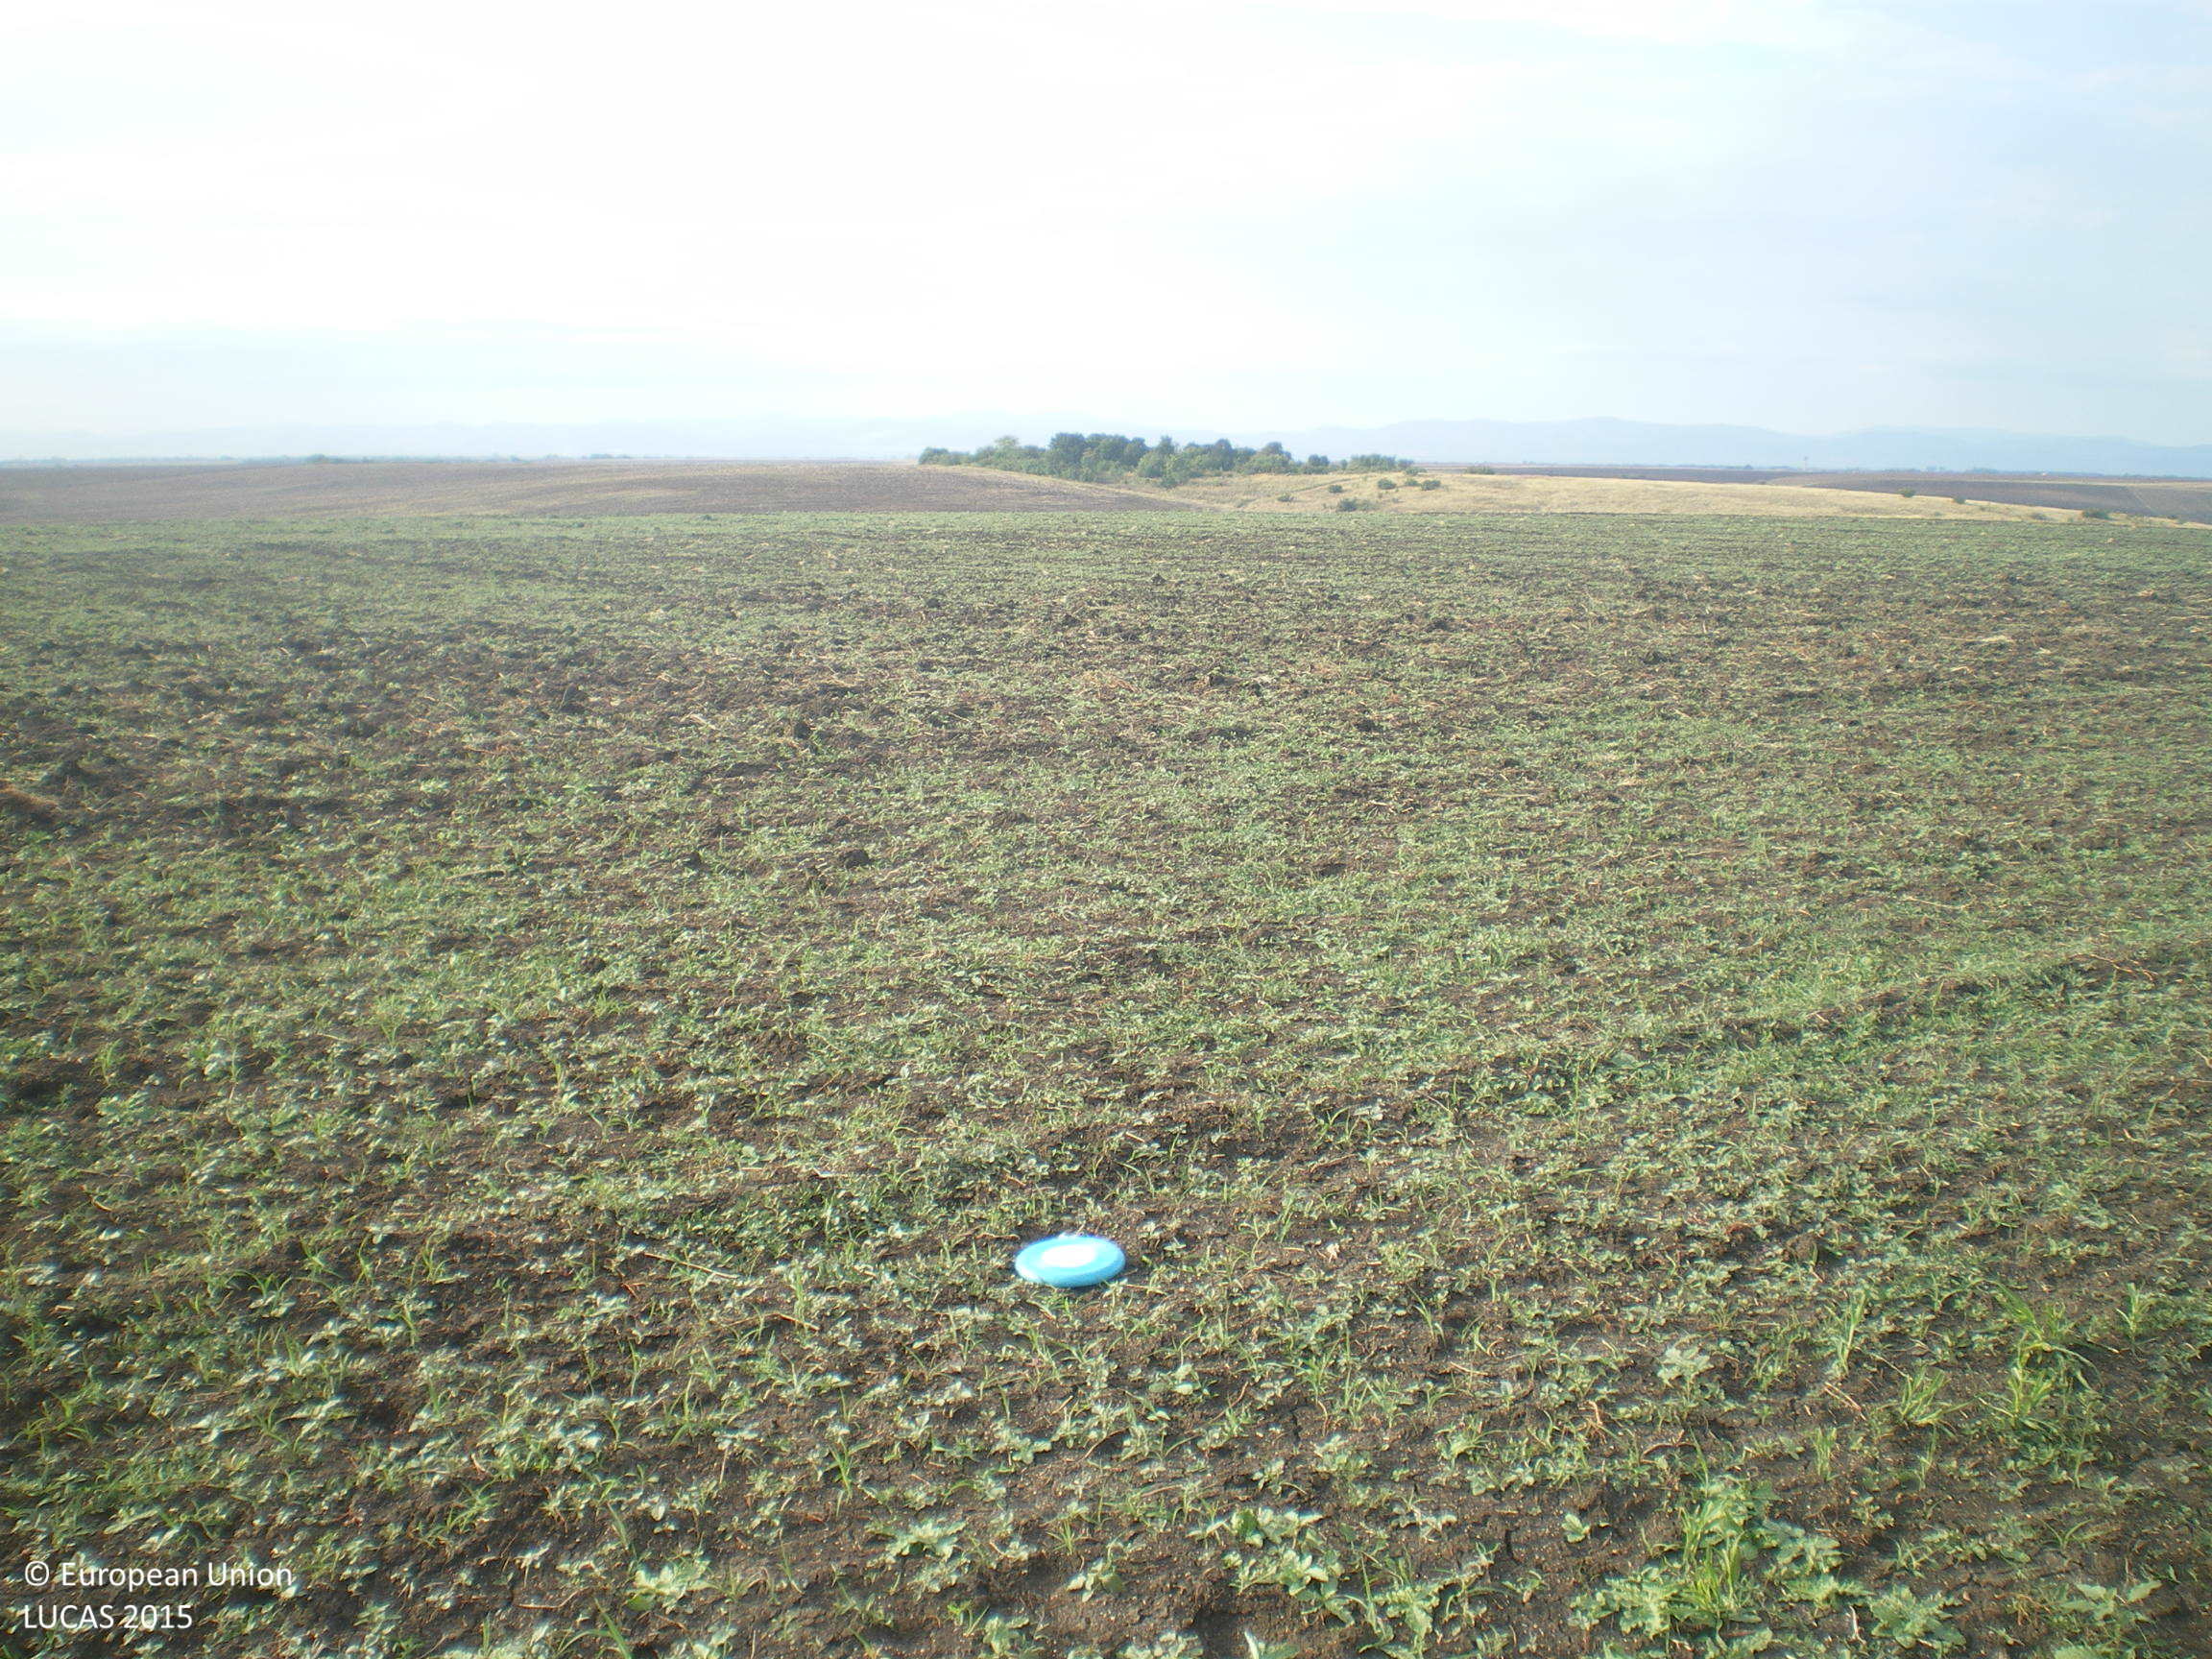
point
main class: Grassland
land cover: Spontaneously vegetated surfaces
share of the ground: 10 - 25 %
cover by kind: herbaceous plants 60 %, consolidated bare surface 40 %
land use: Agriculture (excluding fallow land and kitchen gardens)
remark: Harvested field
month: September
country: BG
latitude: 42.2117
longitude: 25.8078
